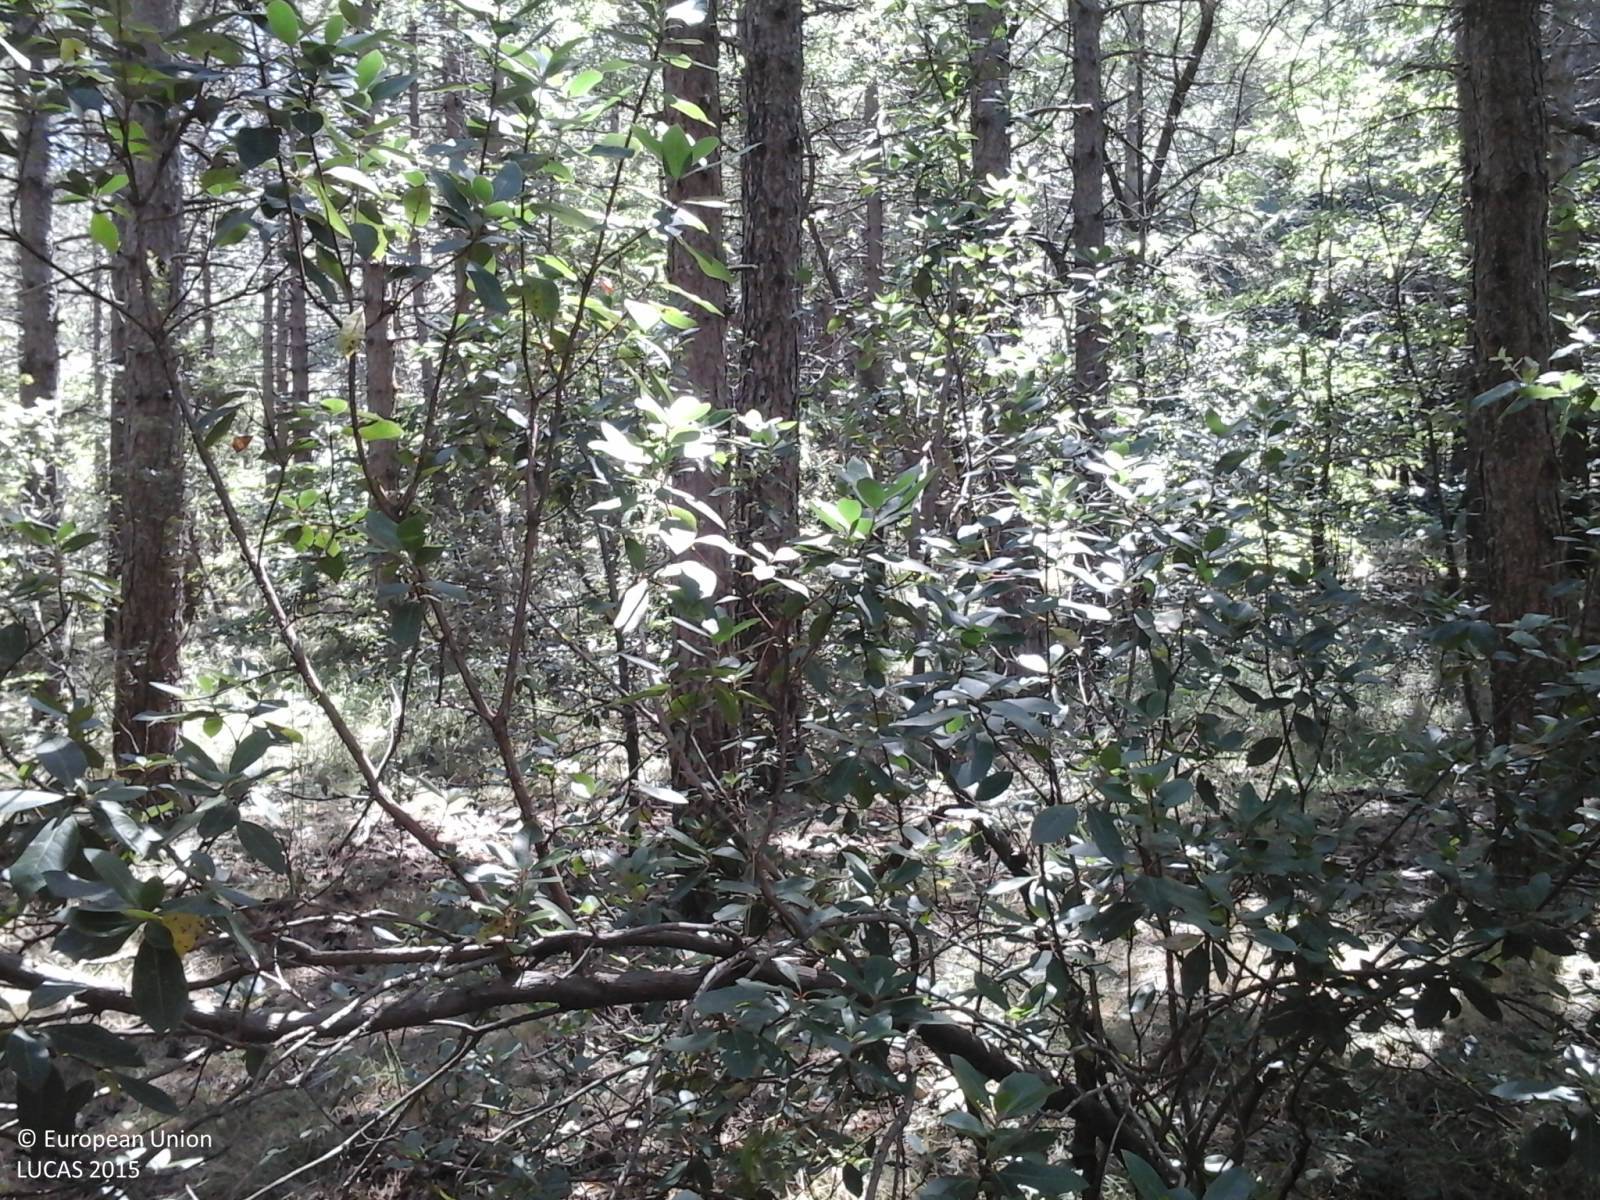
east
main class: Woodland
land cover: Pine dominated coniferous woodland
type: coniferous forest of the mediterranean region
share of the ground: > 75 %
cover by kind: herbaceous plants 80 %, coniferous forest trees 10 %, shrubs 10 %
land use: Forestry
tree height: > 5 m
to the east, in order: Pine dominated coniferous woodland; Tracks; Pine dominated coniferous woodland; Rocks and stones; Shrubland with sparse tree cover
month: August
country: IT
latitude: 40.8610
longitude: 9.1617
